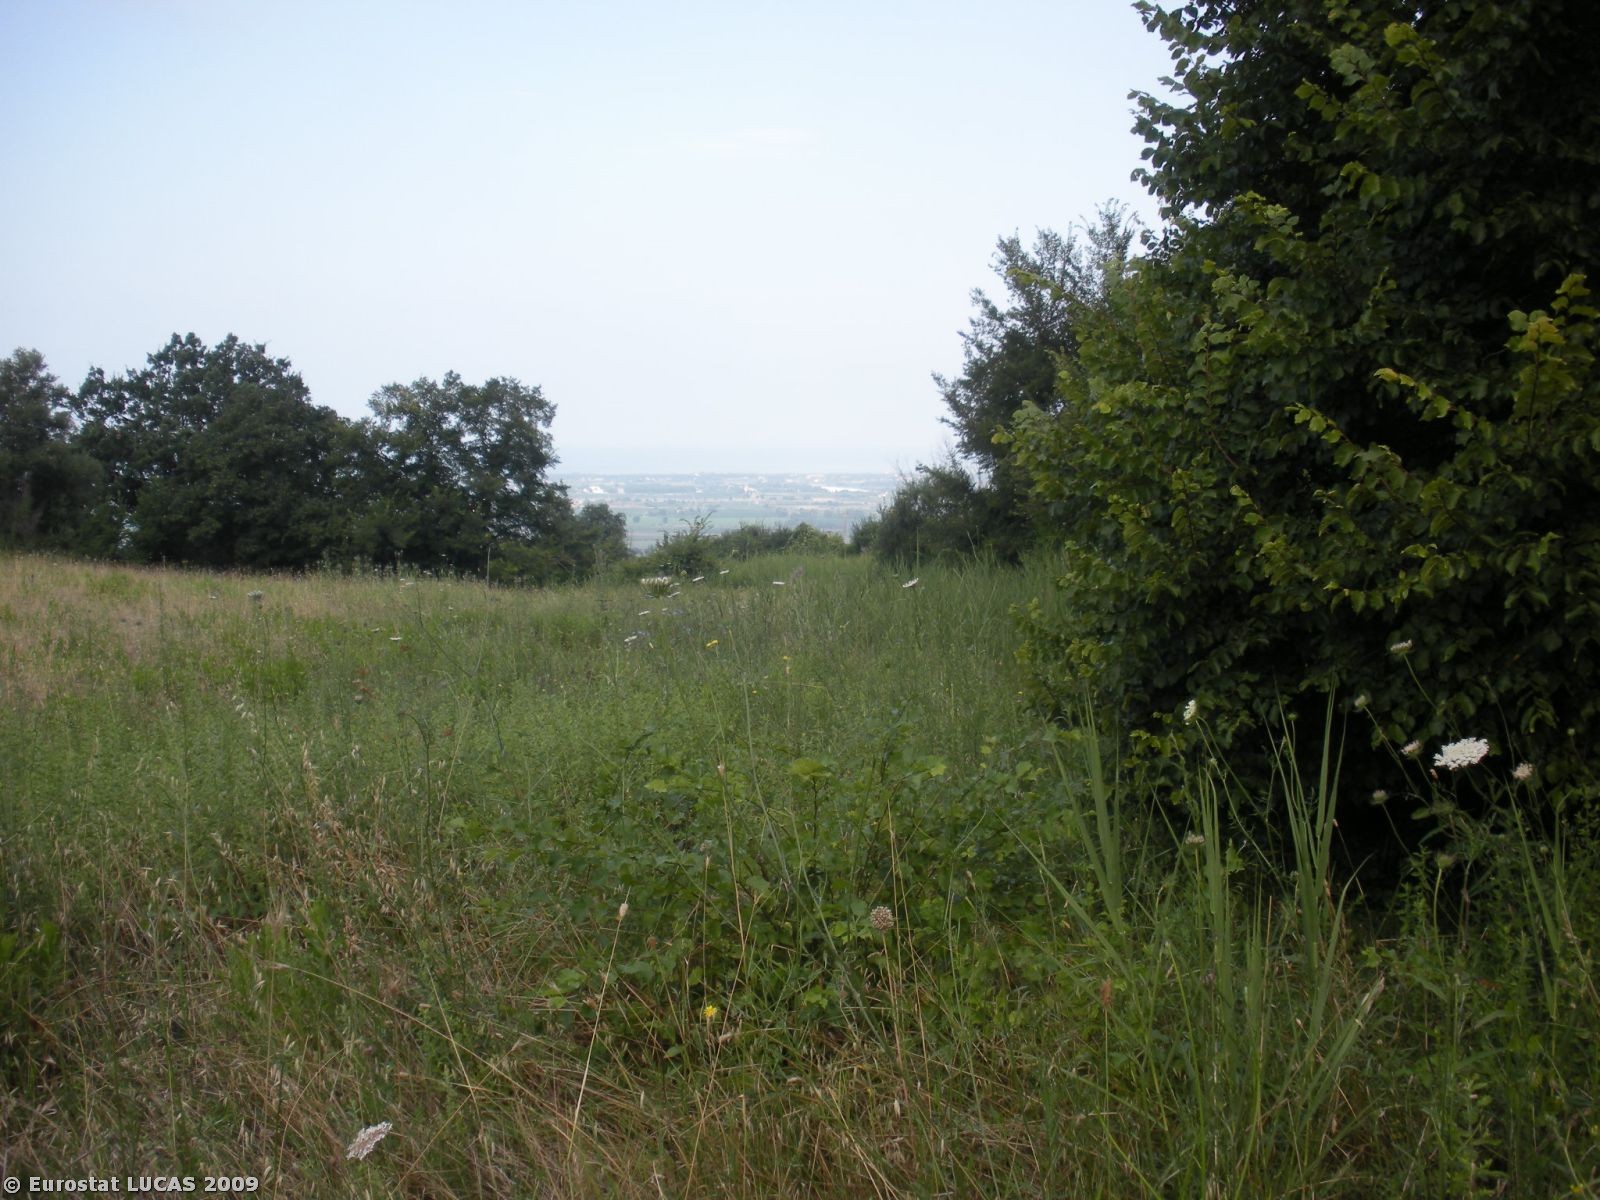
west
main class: Grassland
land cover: Grassland with sparse tree/shrub cover
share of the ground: > 75 %
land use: Fallow land
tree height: < 5 m
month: July
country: IT
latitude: 40.4269
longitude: 15.0584
